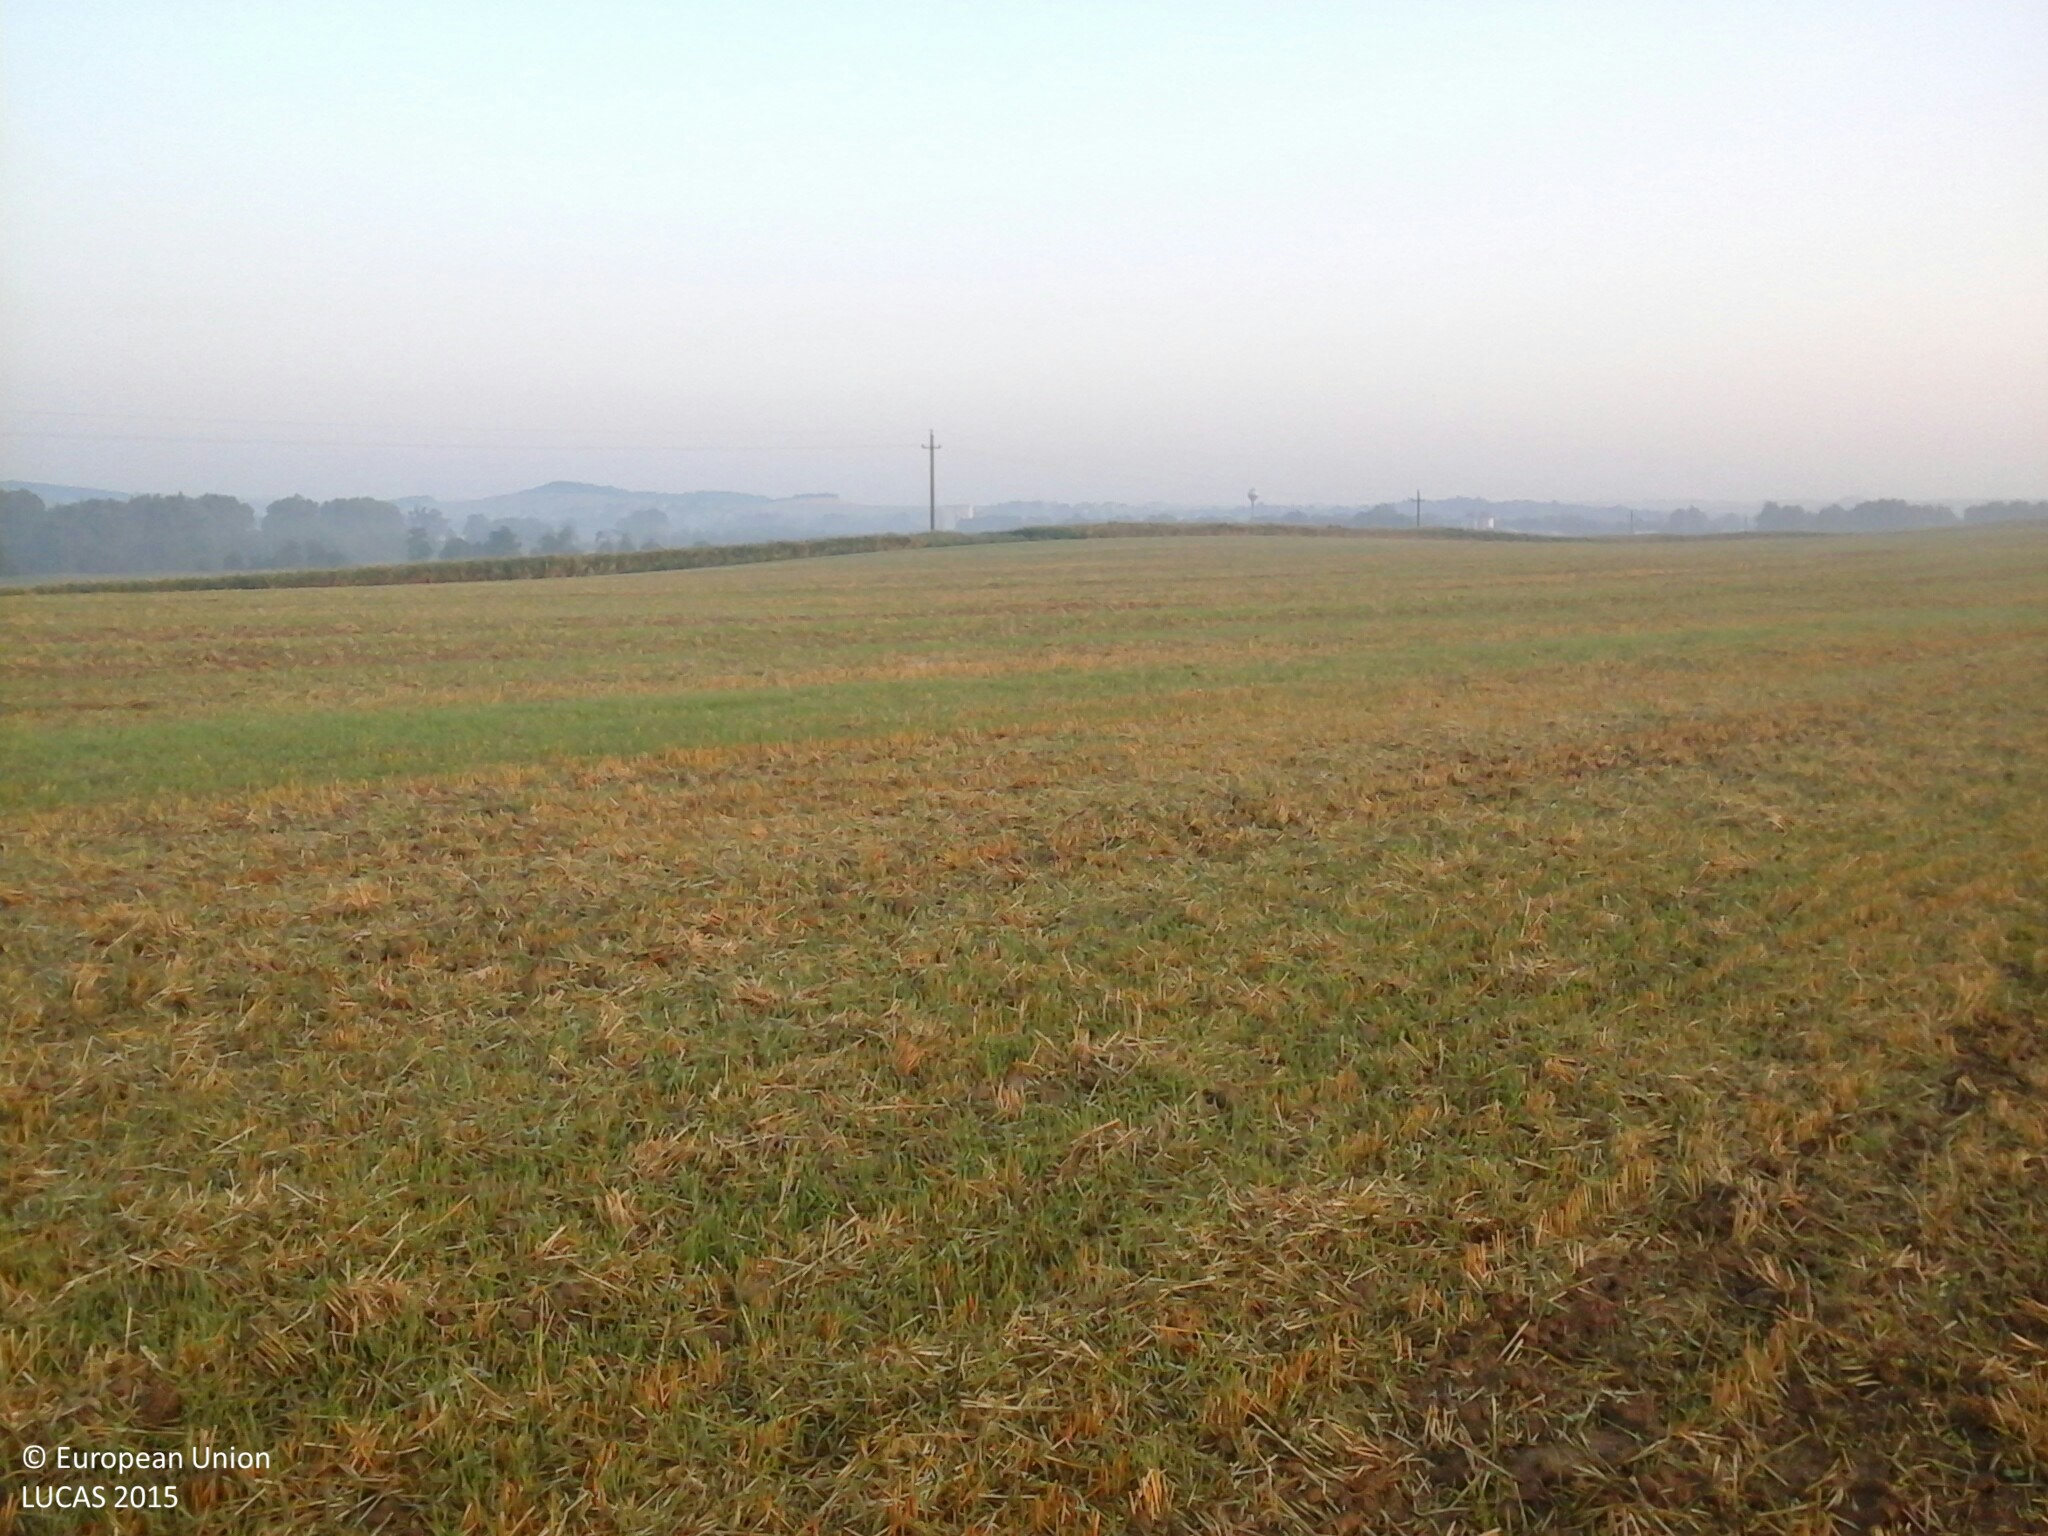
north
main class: Cropland
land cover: Common wheat
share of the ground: 50 - 75 %
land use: Agriculture (excluding fallow land and kitchen gardens)
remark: Harvested field
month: August
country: HU
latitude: 47.5272
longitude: 18.3407
